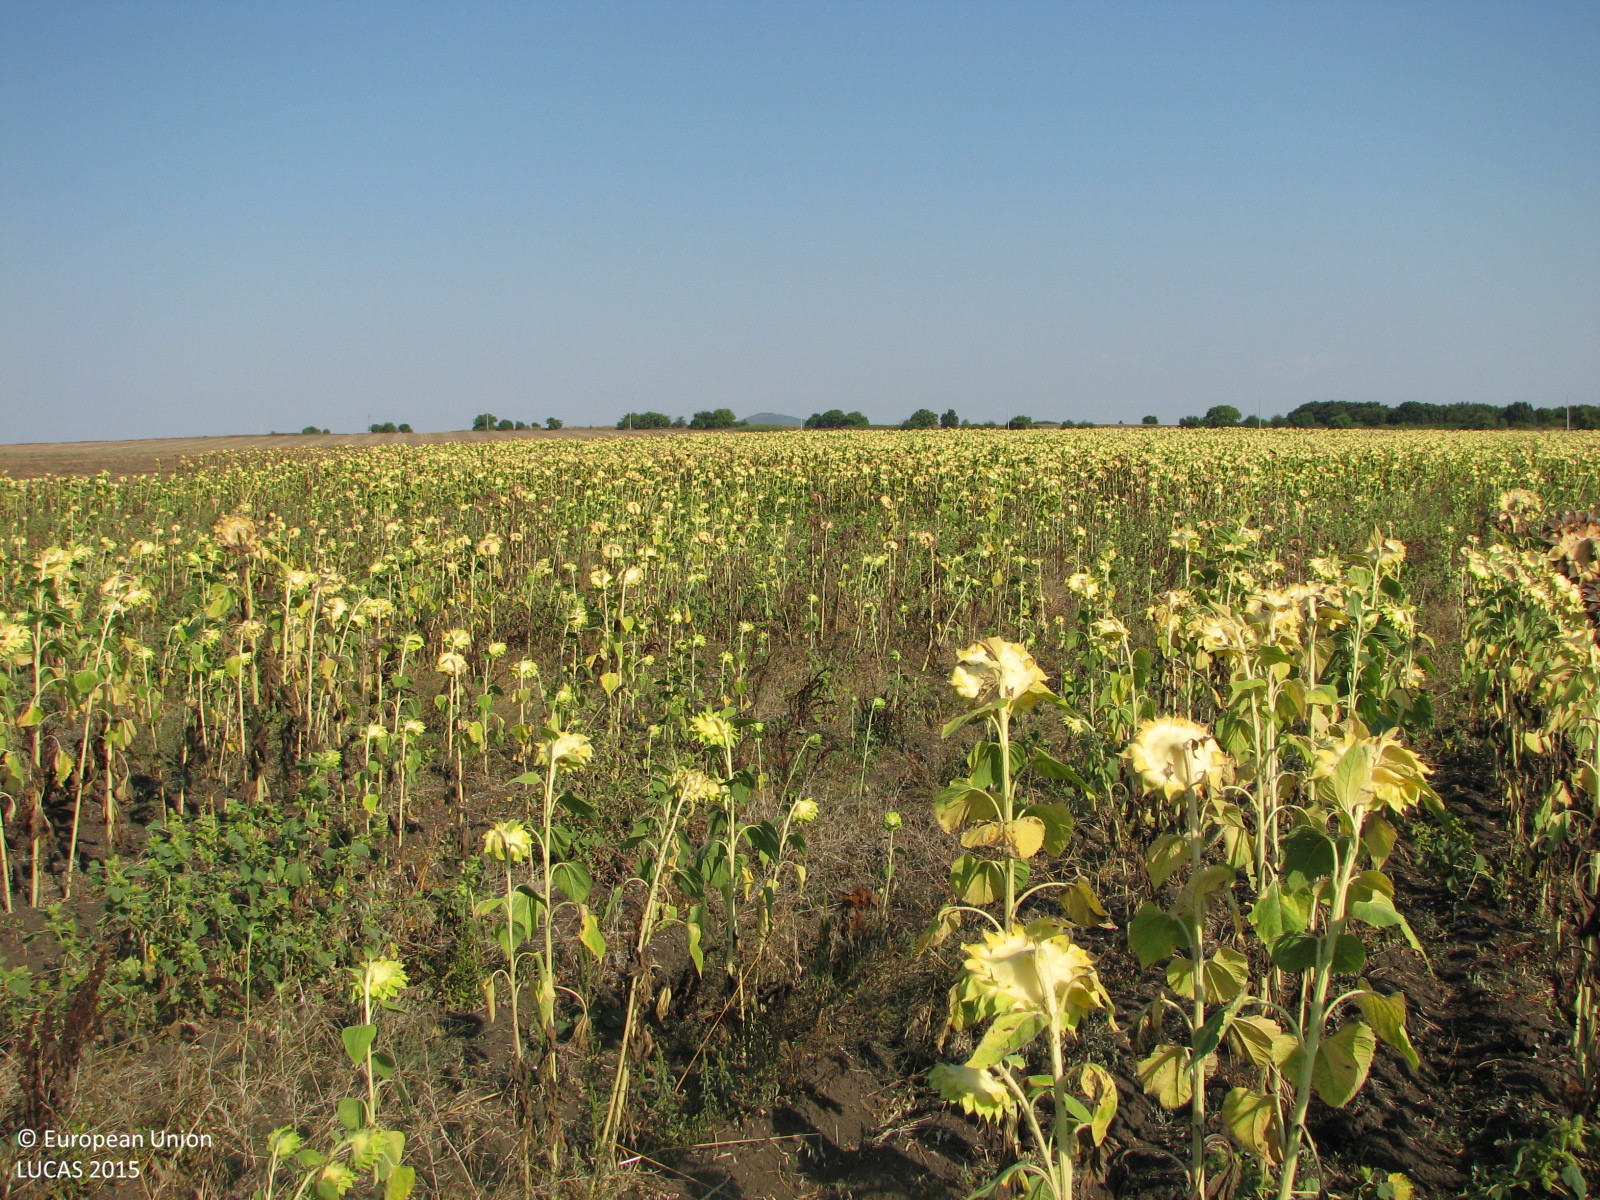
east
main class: Cropland
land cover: Sunflower
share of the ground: > 75 %
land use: Agriculture (excluding fallow land and kitchen gardens)
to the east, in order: Sunflower; Grass margins; Common wheat
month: September
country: BG
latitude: 42.3749
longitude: 26.7216
